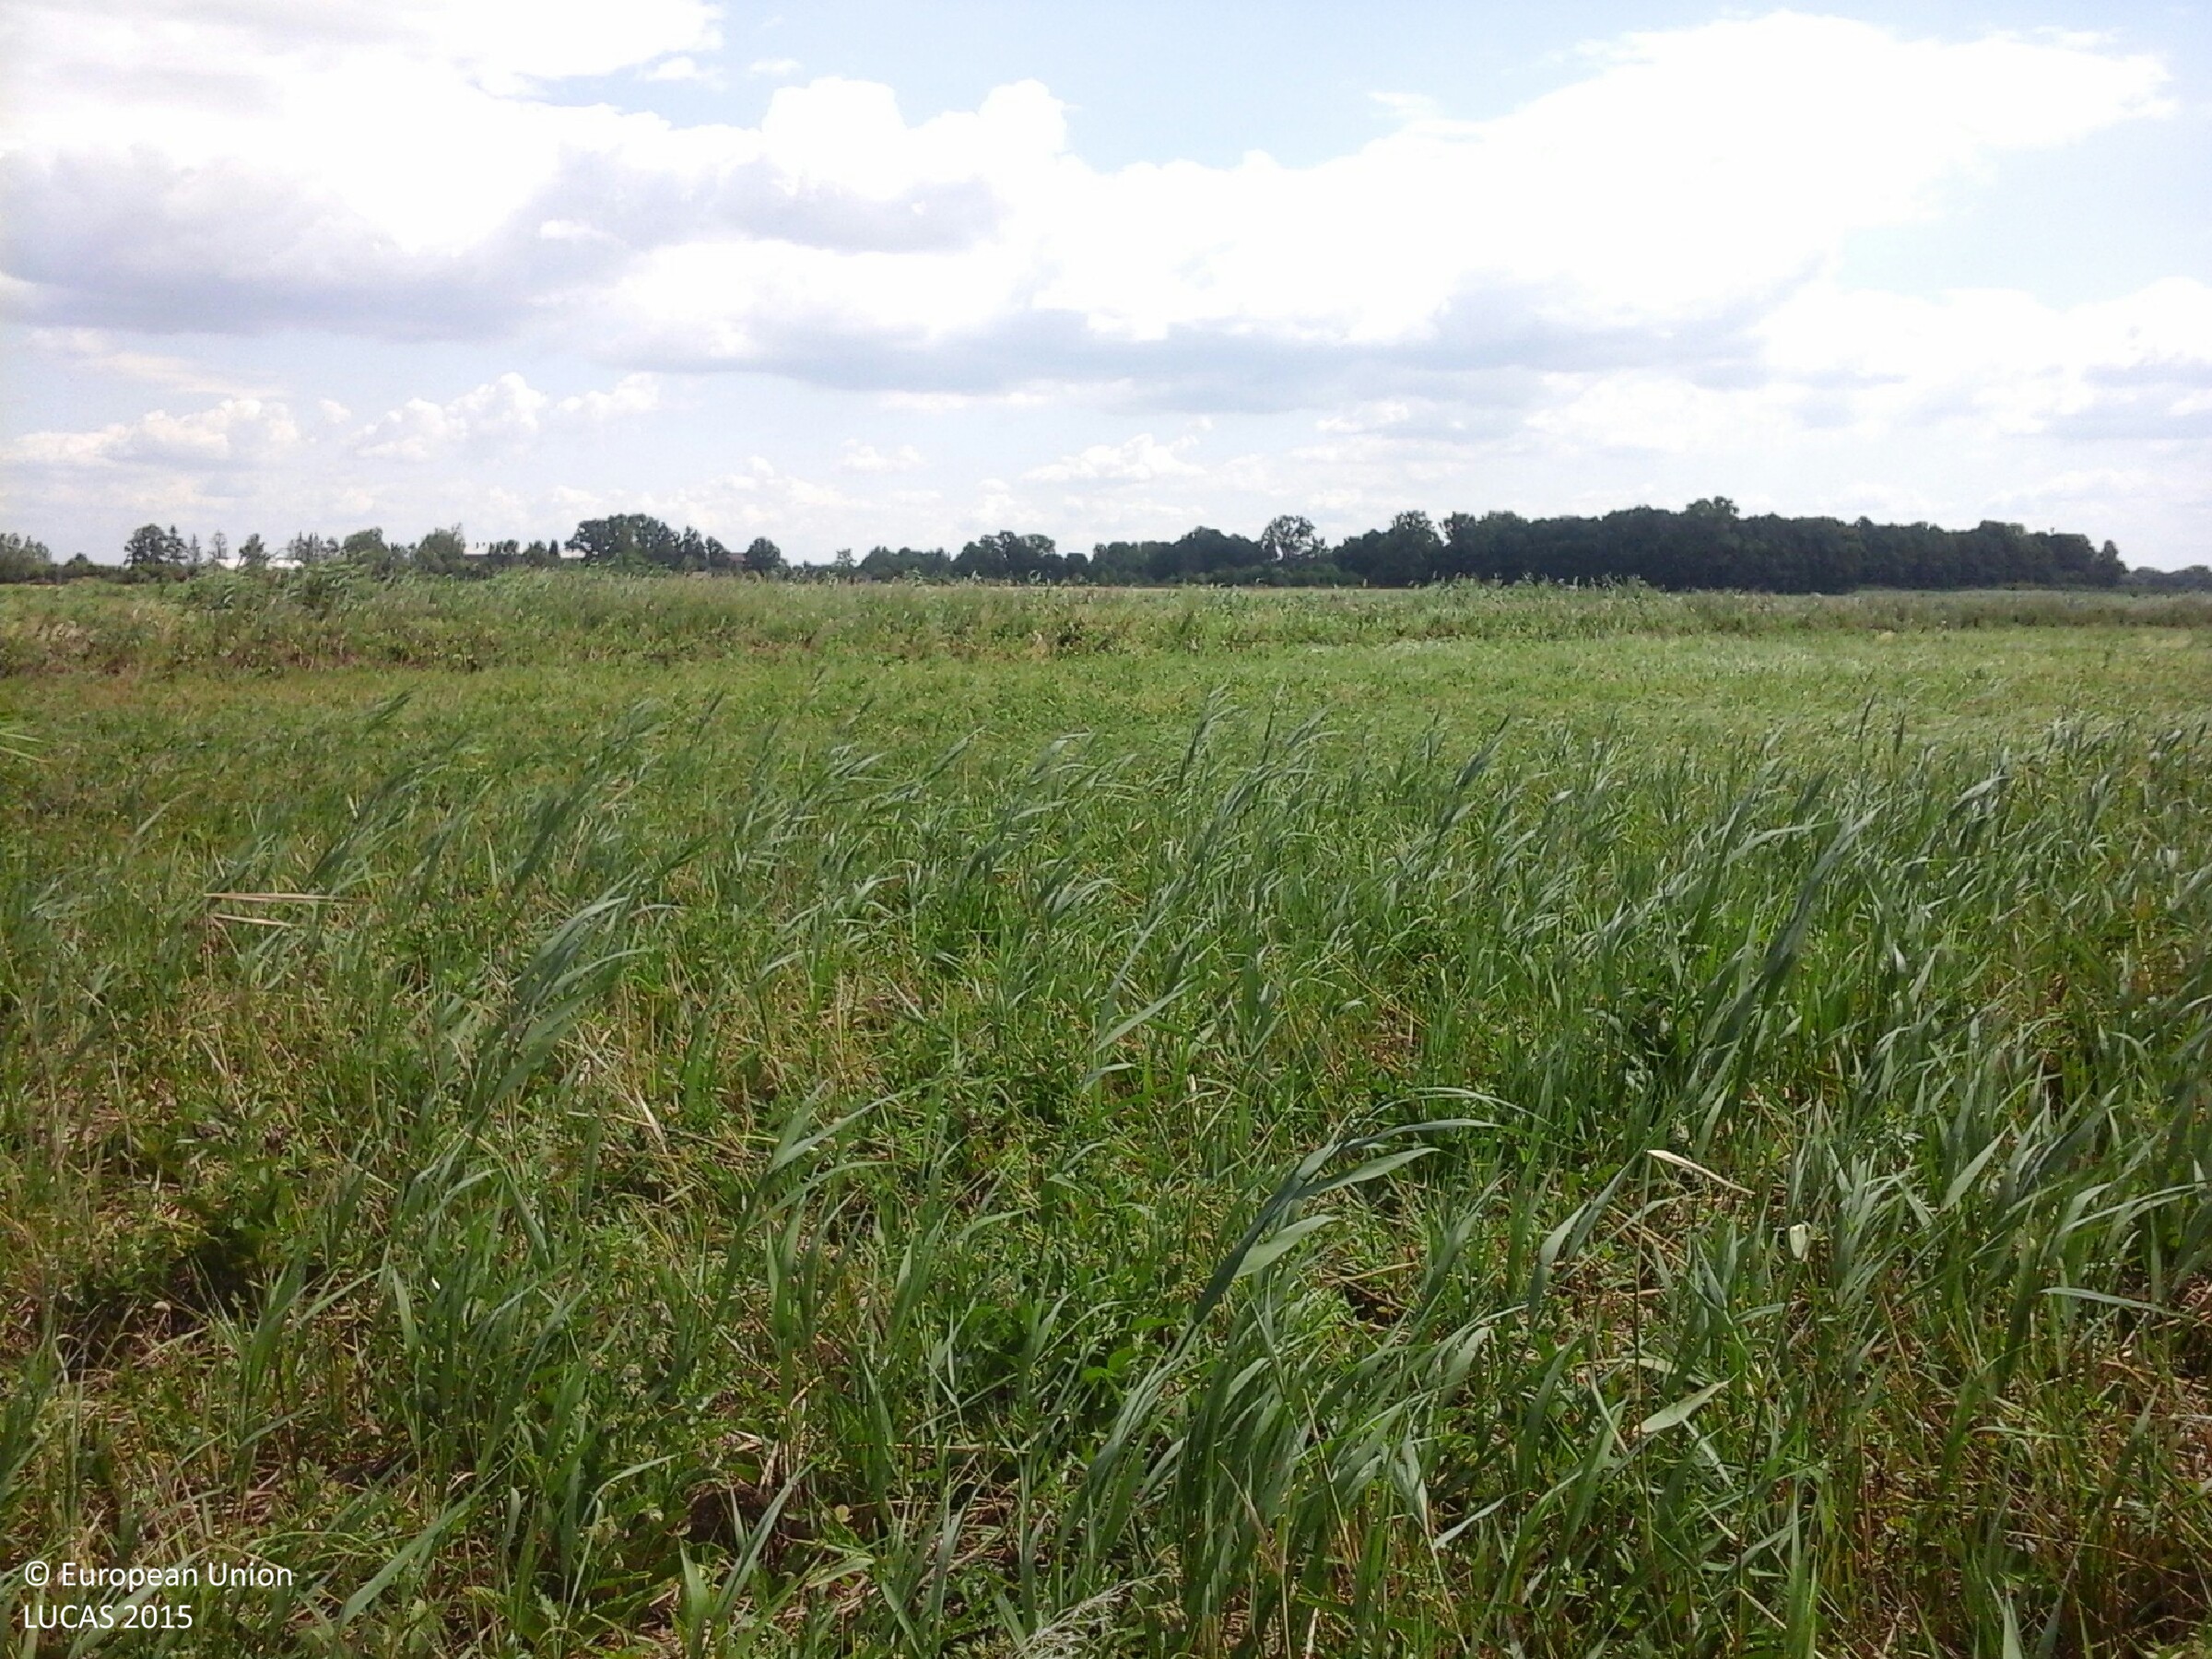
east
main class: Cropland
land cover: Permanent industrial crops
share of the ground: > 75 %
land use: Agriculture (excluding fallow land and kitchen gardens)
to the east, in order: Permanent industrial crops; Ditches and canals; Grassland without tree/shrub cover; Ditches and canals; Grassland without tree/shrub cover
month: July
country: HU
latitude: 47.7819
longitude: 20.6174
